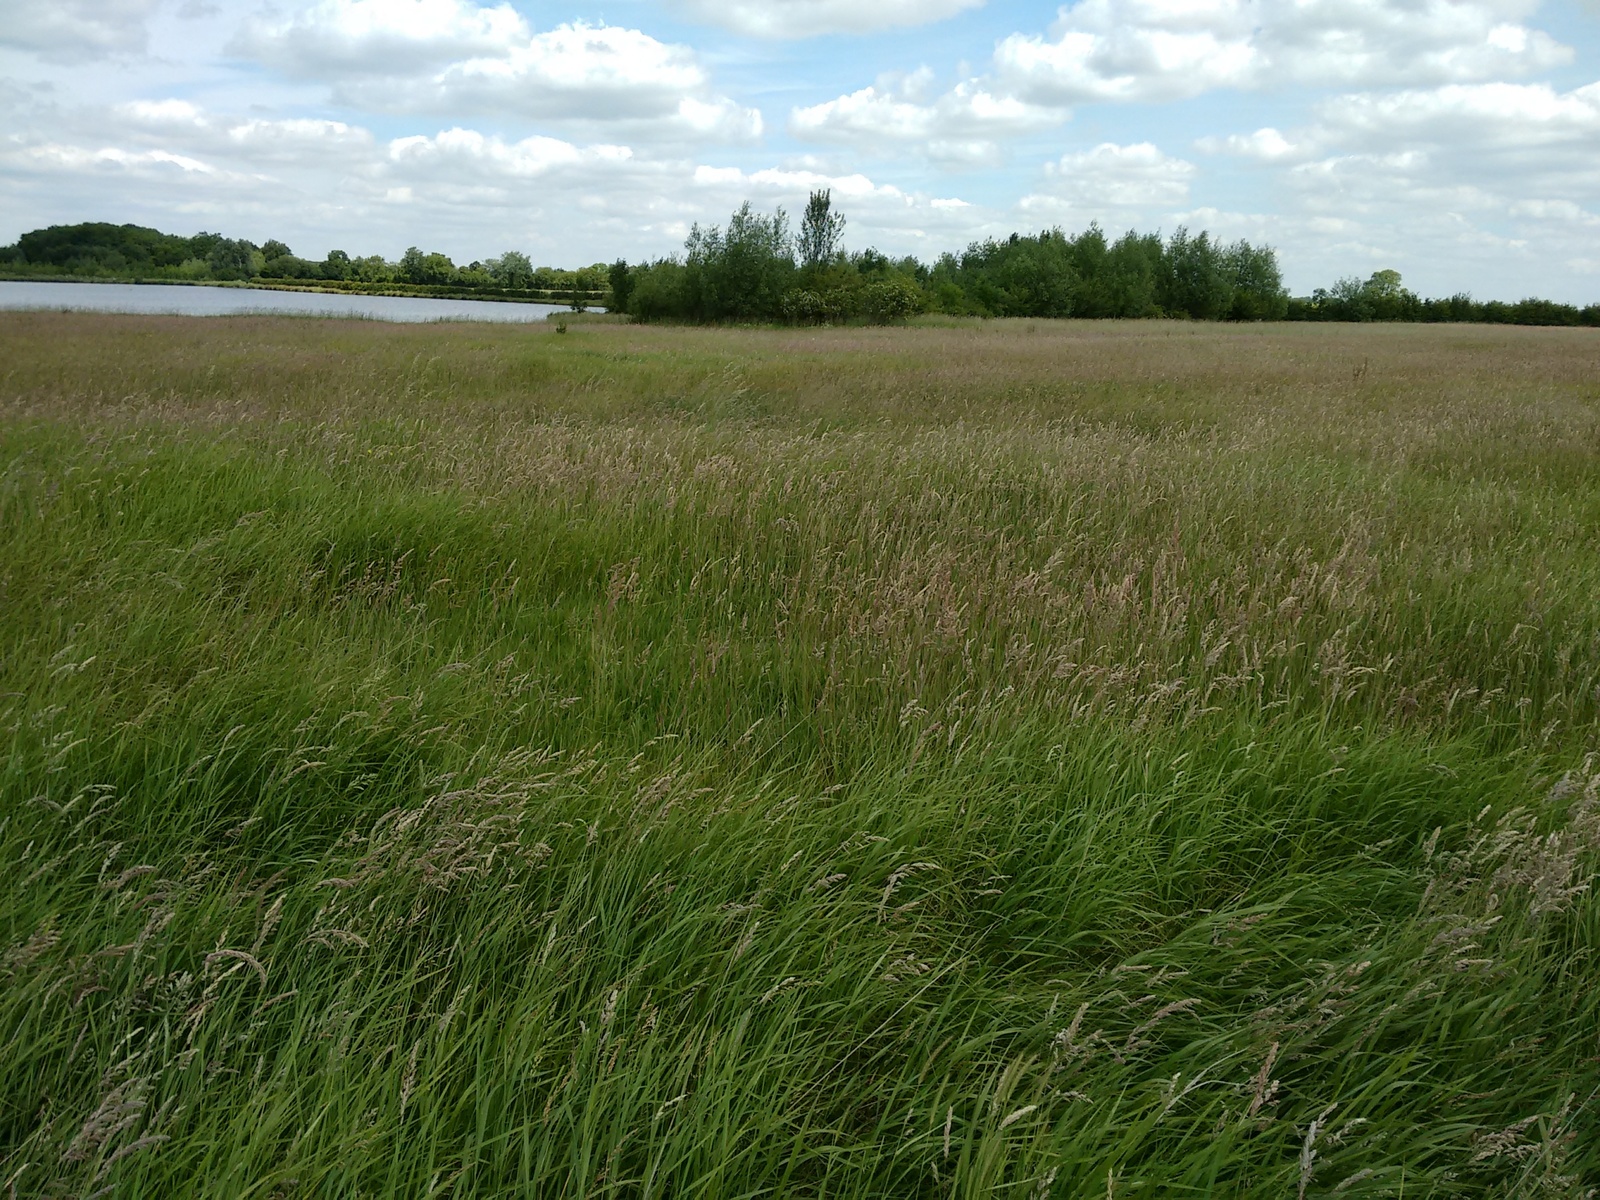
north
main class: Grassland
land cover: Grassland without tree/shrub cover
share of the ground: > 75 %
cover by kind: herbaceous plants 100 %
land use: Agriculture (excluding fallow land and kitchen gardens)
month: June
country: GB
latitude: 51.6134
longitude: -1.5326
